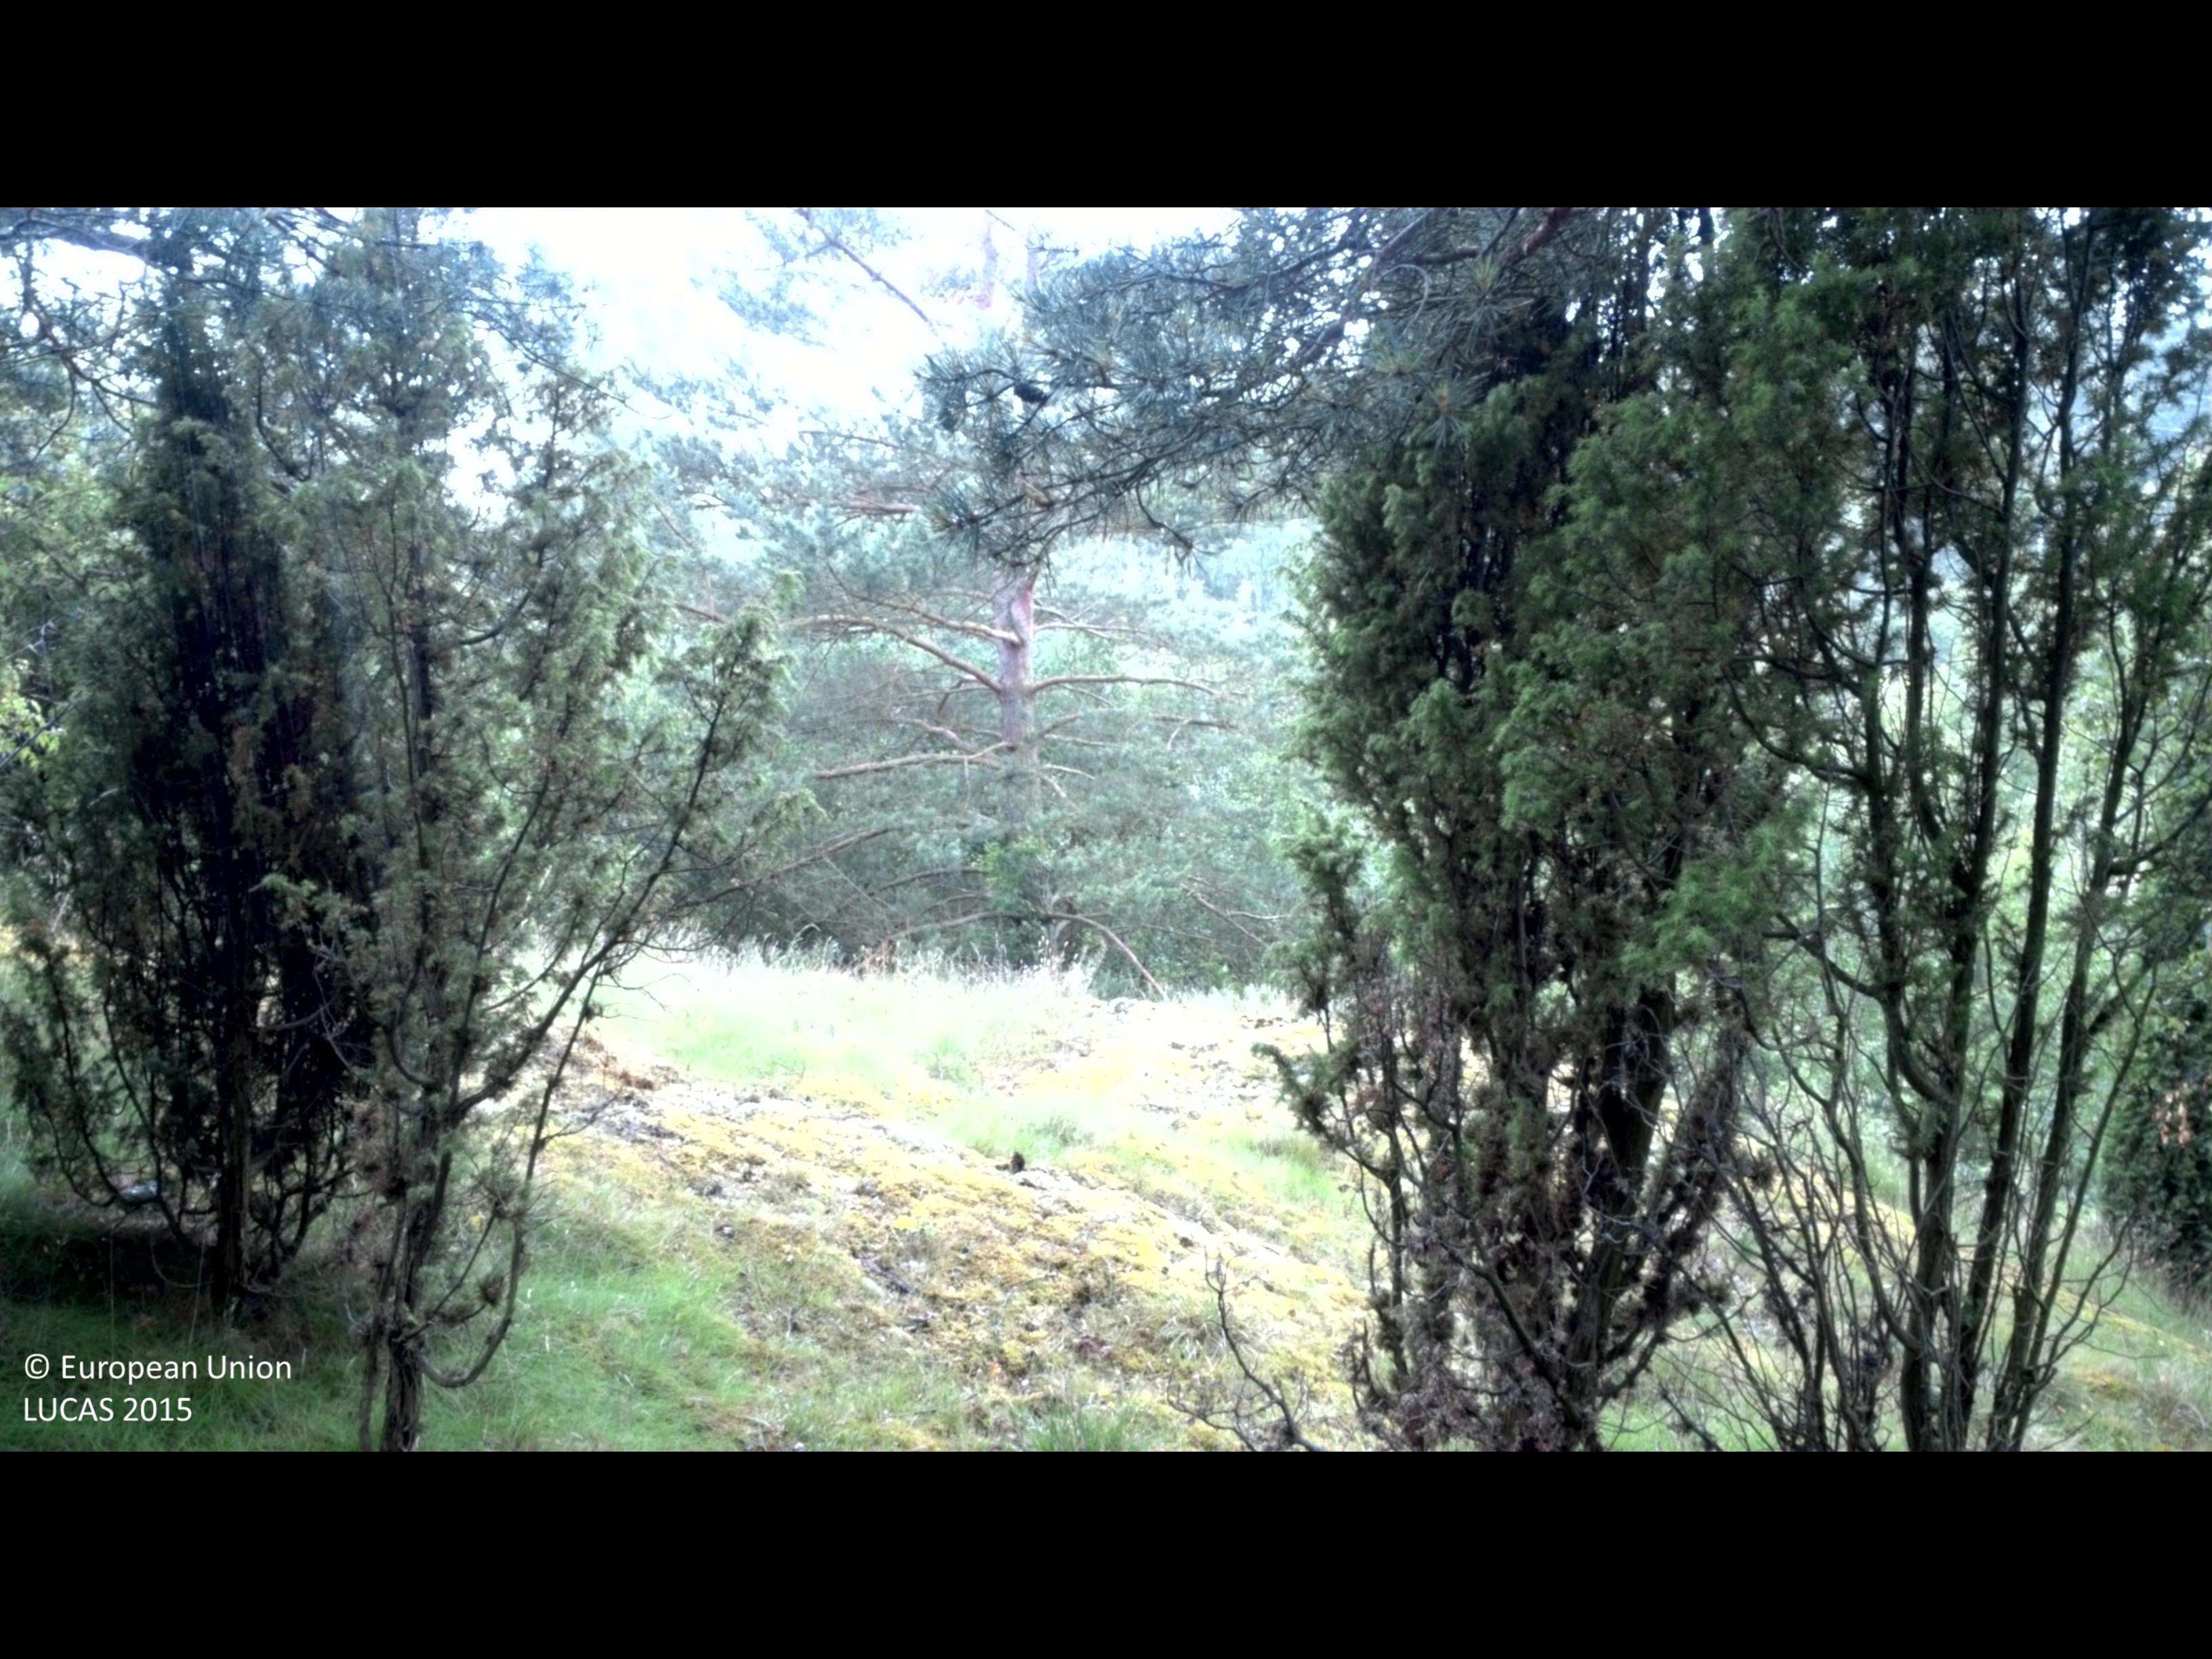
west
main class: Woodland
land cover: Other coniferous woodland
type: boreal forest
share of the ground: 50 - 75 %
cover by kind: coniferous forest trees 60 %, broadleaved forest trees 10 %, shrubs 10 %, herbaceous plants 10 %, lichens and mosses 10 %
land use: Forestry
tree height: > 5 m
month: June
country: SE
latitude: 57.8871
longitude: 16.3900
